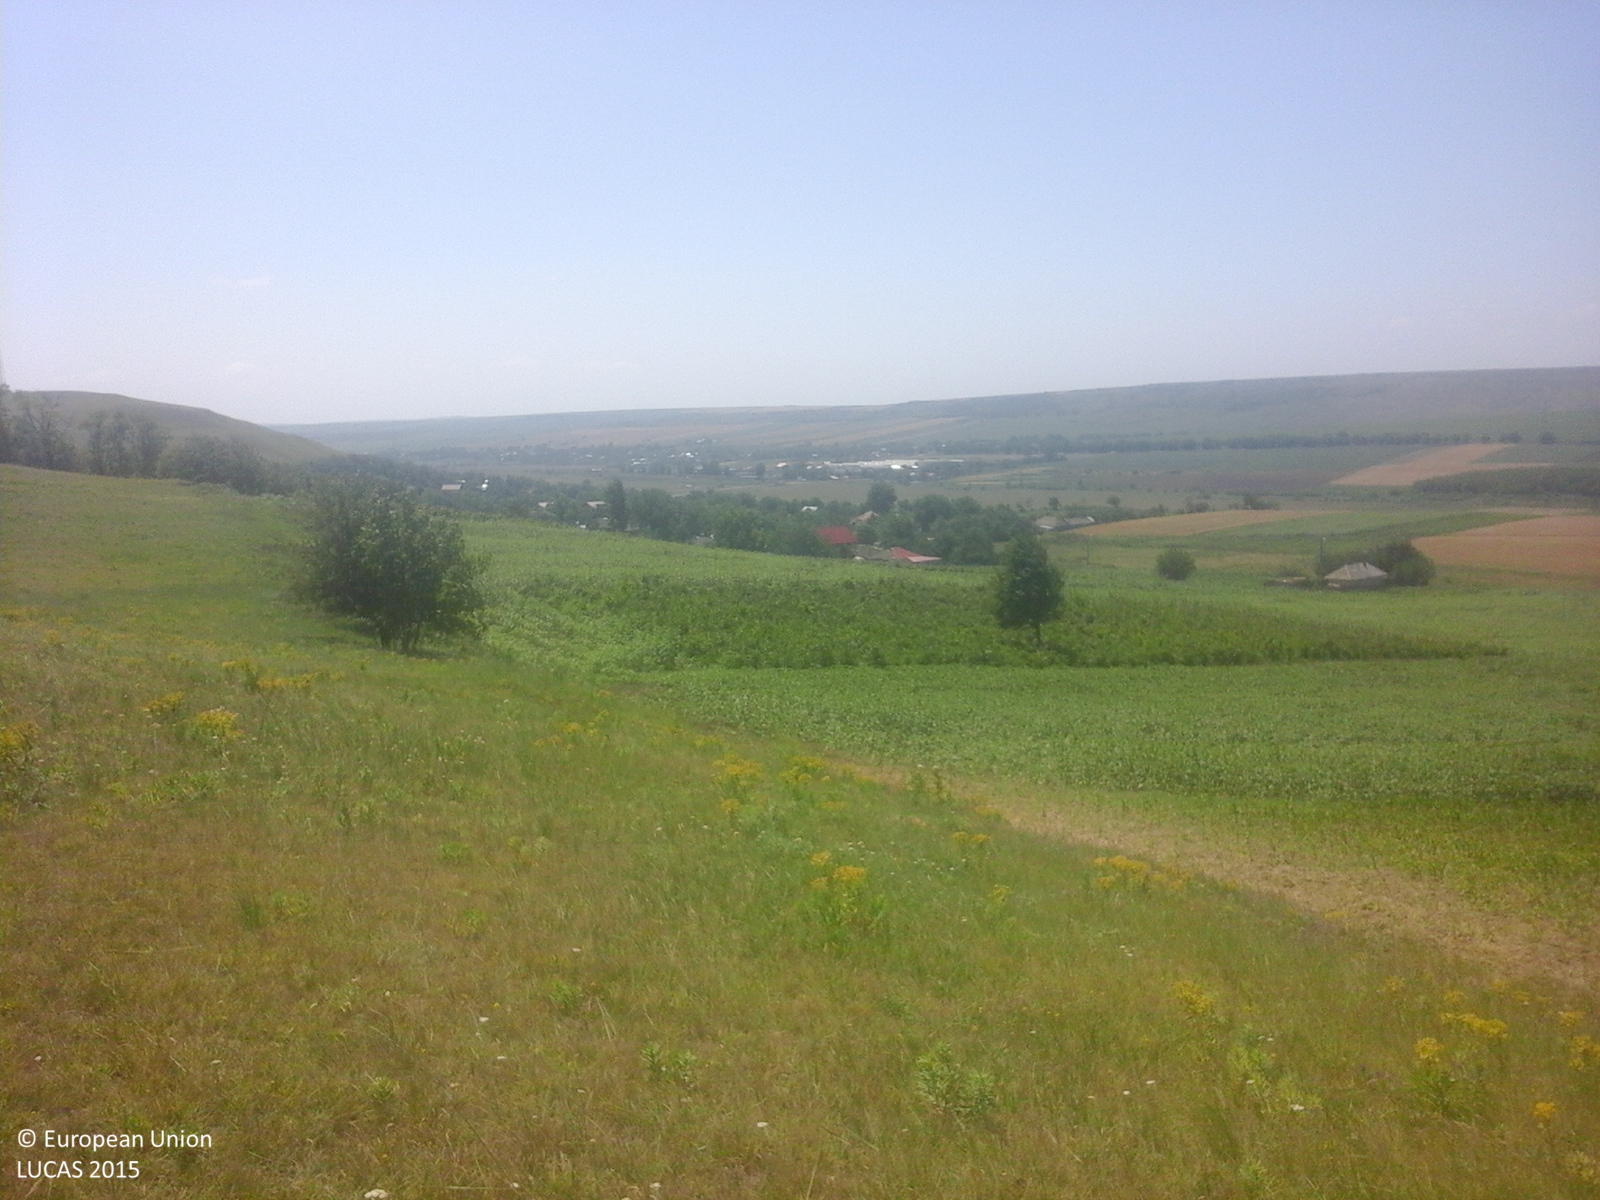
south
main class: Grassland
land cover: Grassland without tree/shrub cover
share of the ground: > 75 %
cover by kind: herbaceous plants 100 %
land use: Agriculture (excluding fallow land and kitchen gardens)
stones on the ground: < 10 %
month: June
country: RO
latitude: 46.8871
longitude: 27.5838
